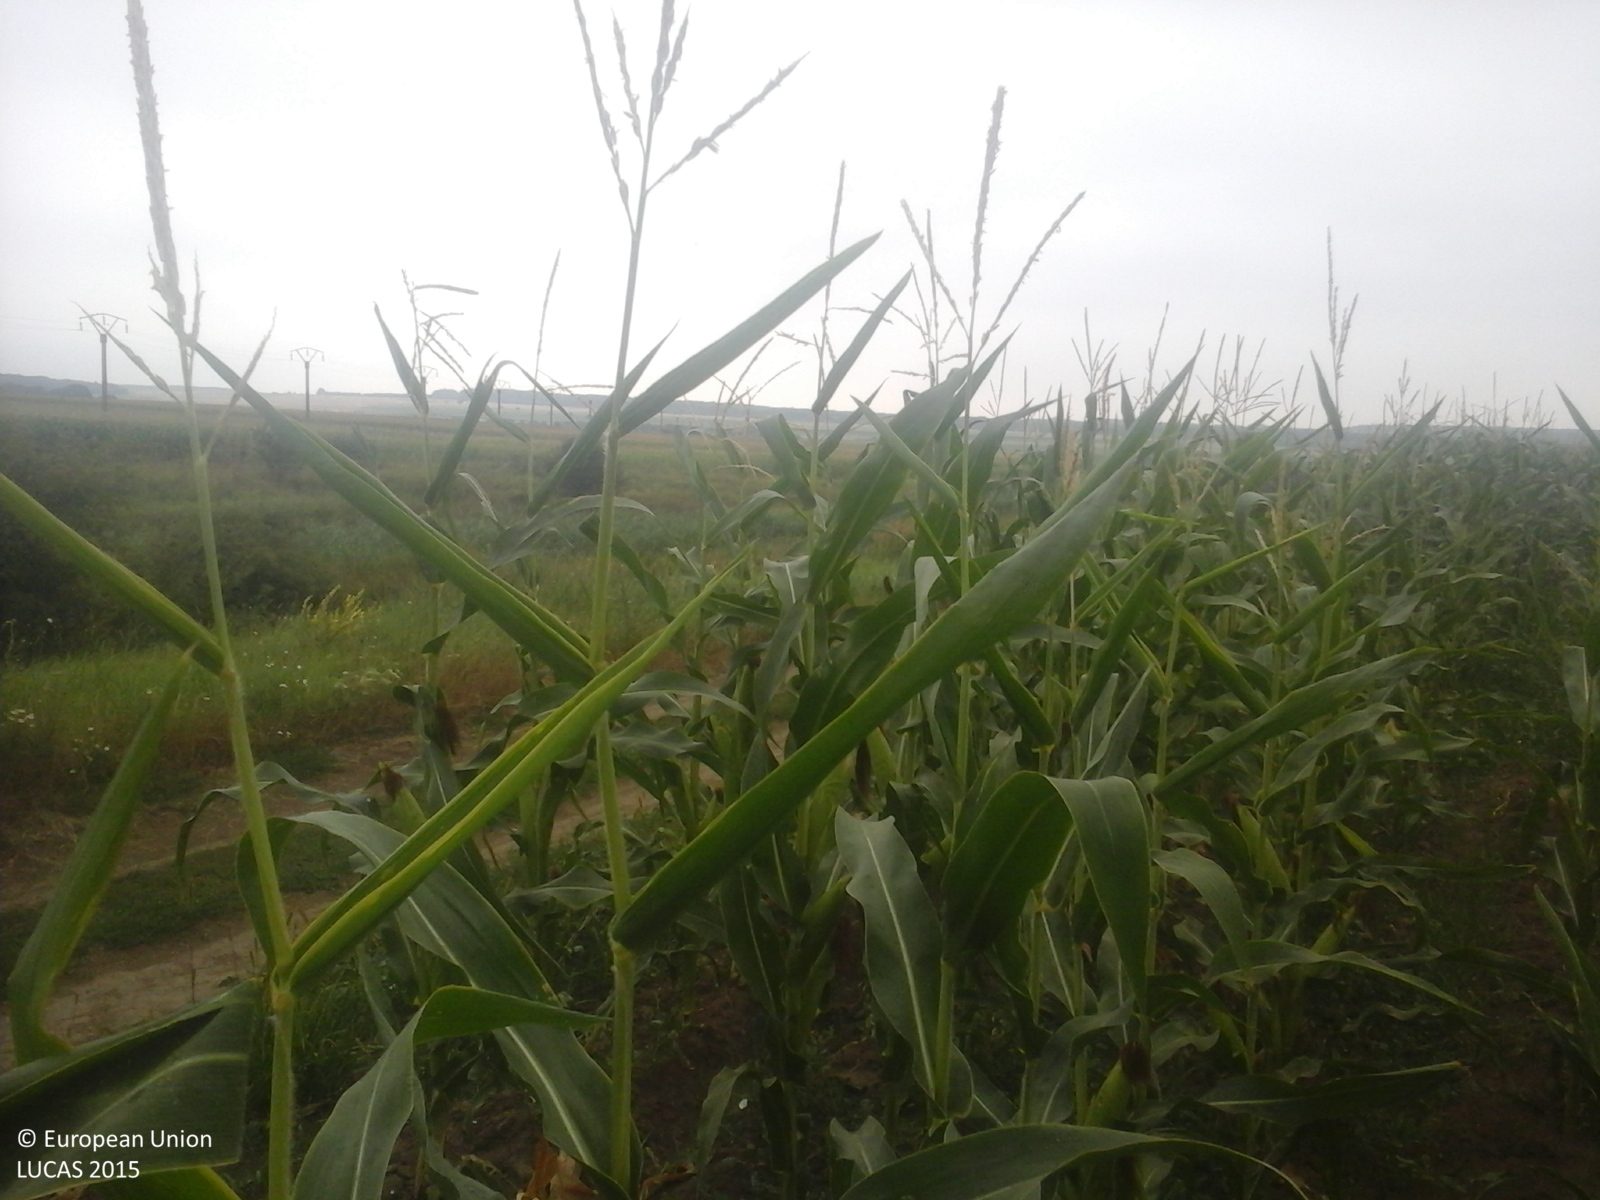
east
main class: Cropland
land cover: Maize
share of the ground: > 75 %
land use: Agriculture (excluding fallow land and kitchen gardens)
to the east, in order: Maize; Grass margins; Tracks; Grassland with sparse tree/shrub cover; Ditches and canals; Grassland without tree/shrub cover; Maize
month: August
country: RO
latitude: 44.8028
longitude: 28.4441
